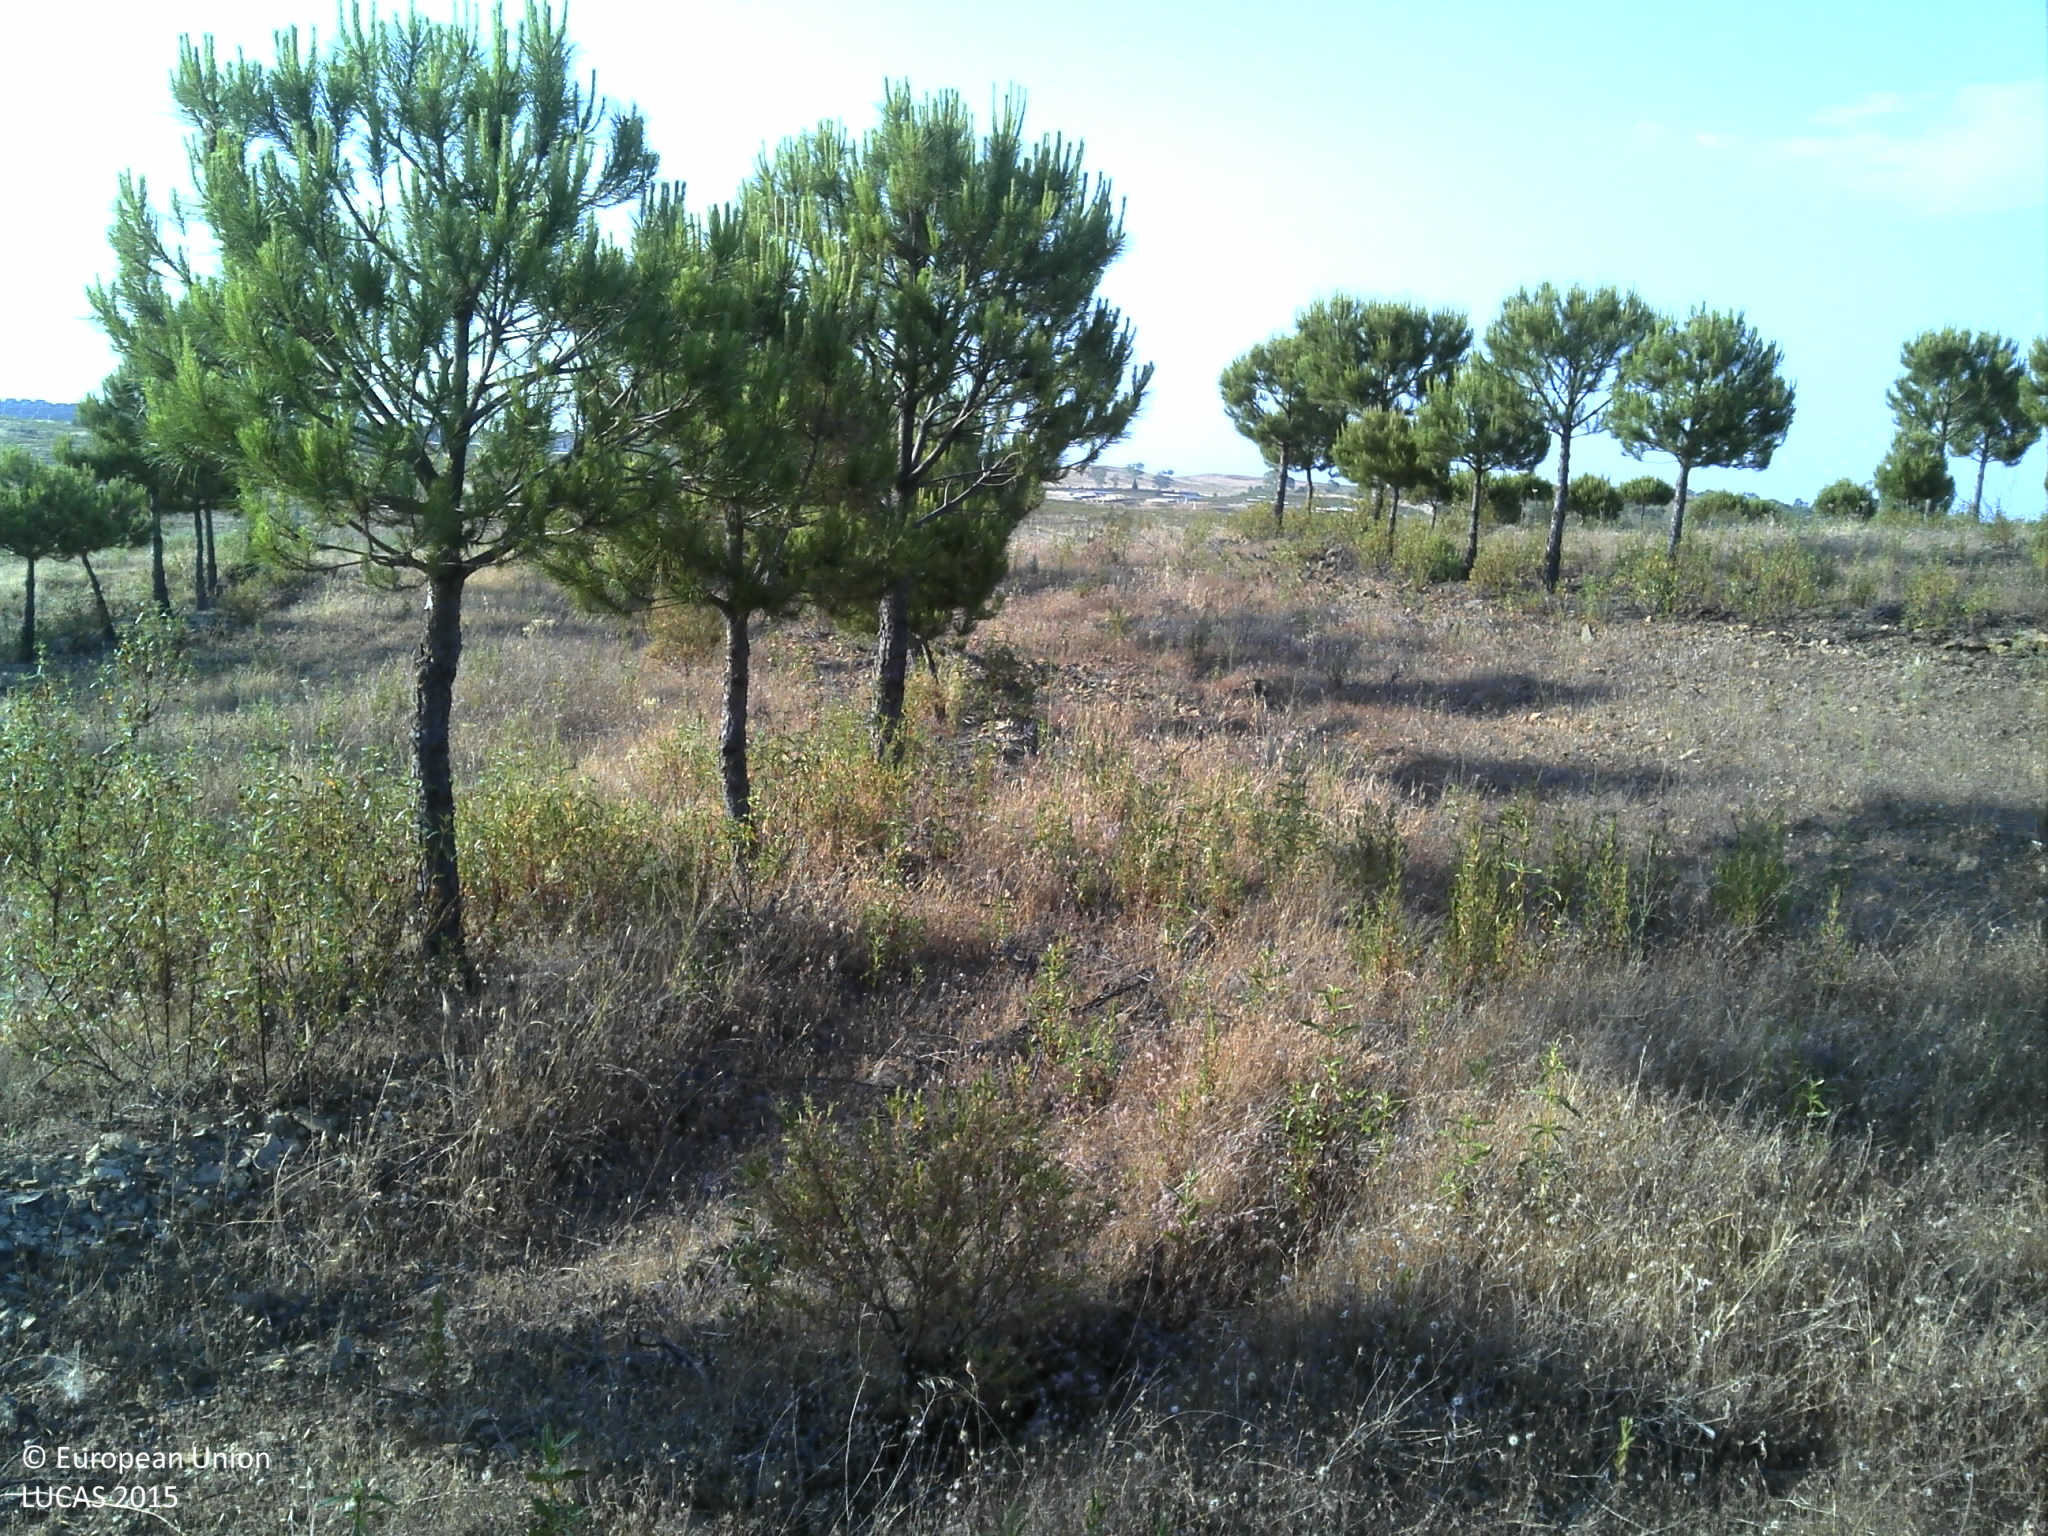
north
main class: Woodland
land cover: Pine dominated coniferous woodland
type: coniferous forest of the mediterranean region
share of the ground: 10 - 25 %
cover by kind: herbaceous plants 50 %, coniferous forest trees 25 %, shrubs 25 %
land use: Forestry
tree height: < 5 m
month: May
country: PT
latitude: 37.4334
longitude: -7.7453
